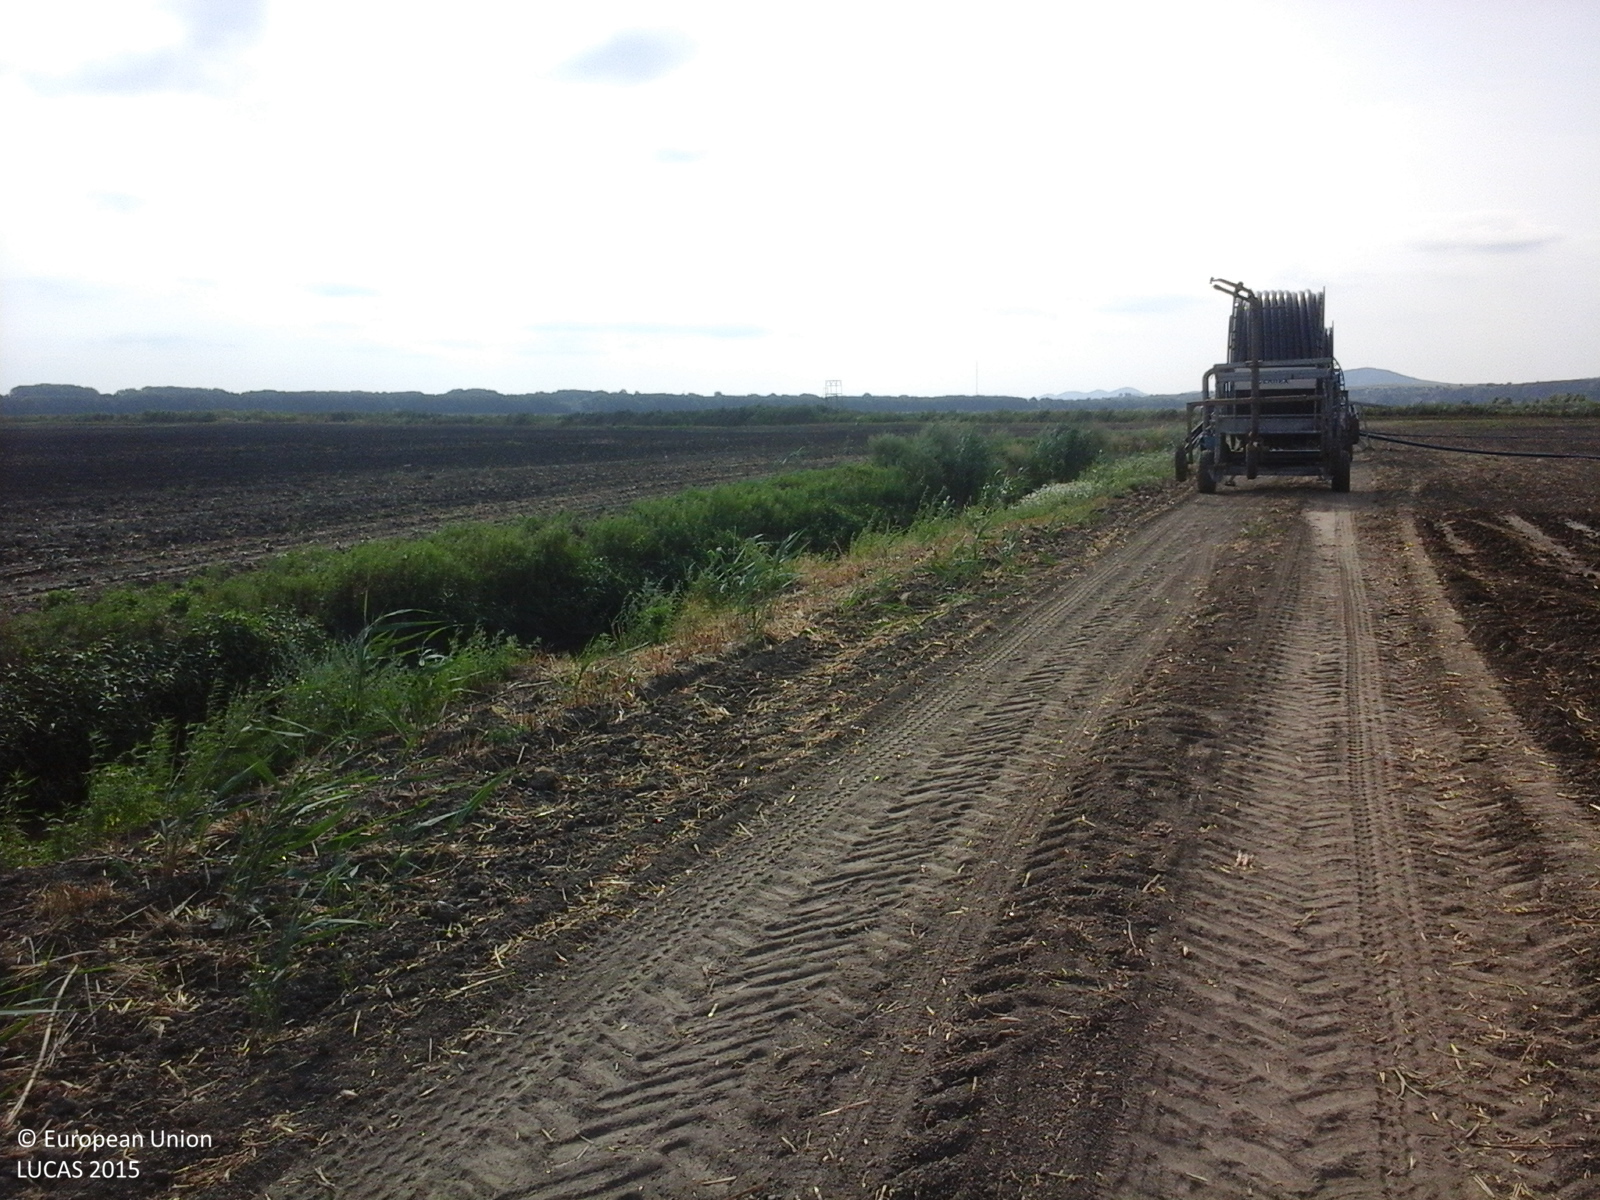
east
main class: Cropland
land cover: Common wheat
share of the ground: 10 - 25 %
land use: Agriculture (excluding fallow land and kitchen gardens)
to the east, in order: Tracks; Grass margins; Ditches and canals; Grass margins; Common wheat
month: August
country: RO
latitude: 45.1664
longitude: 28.8843
